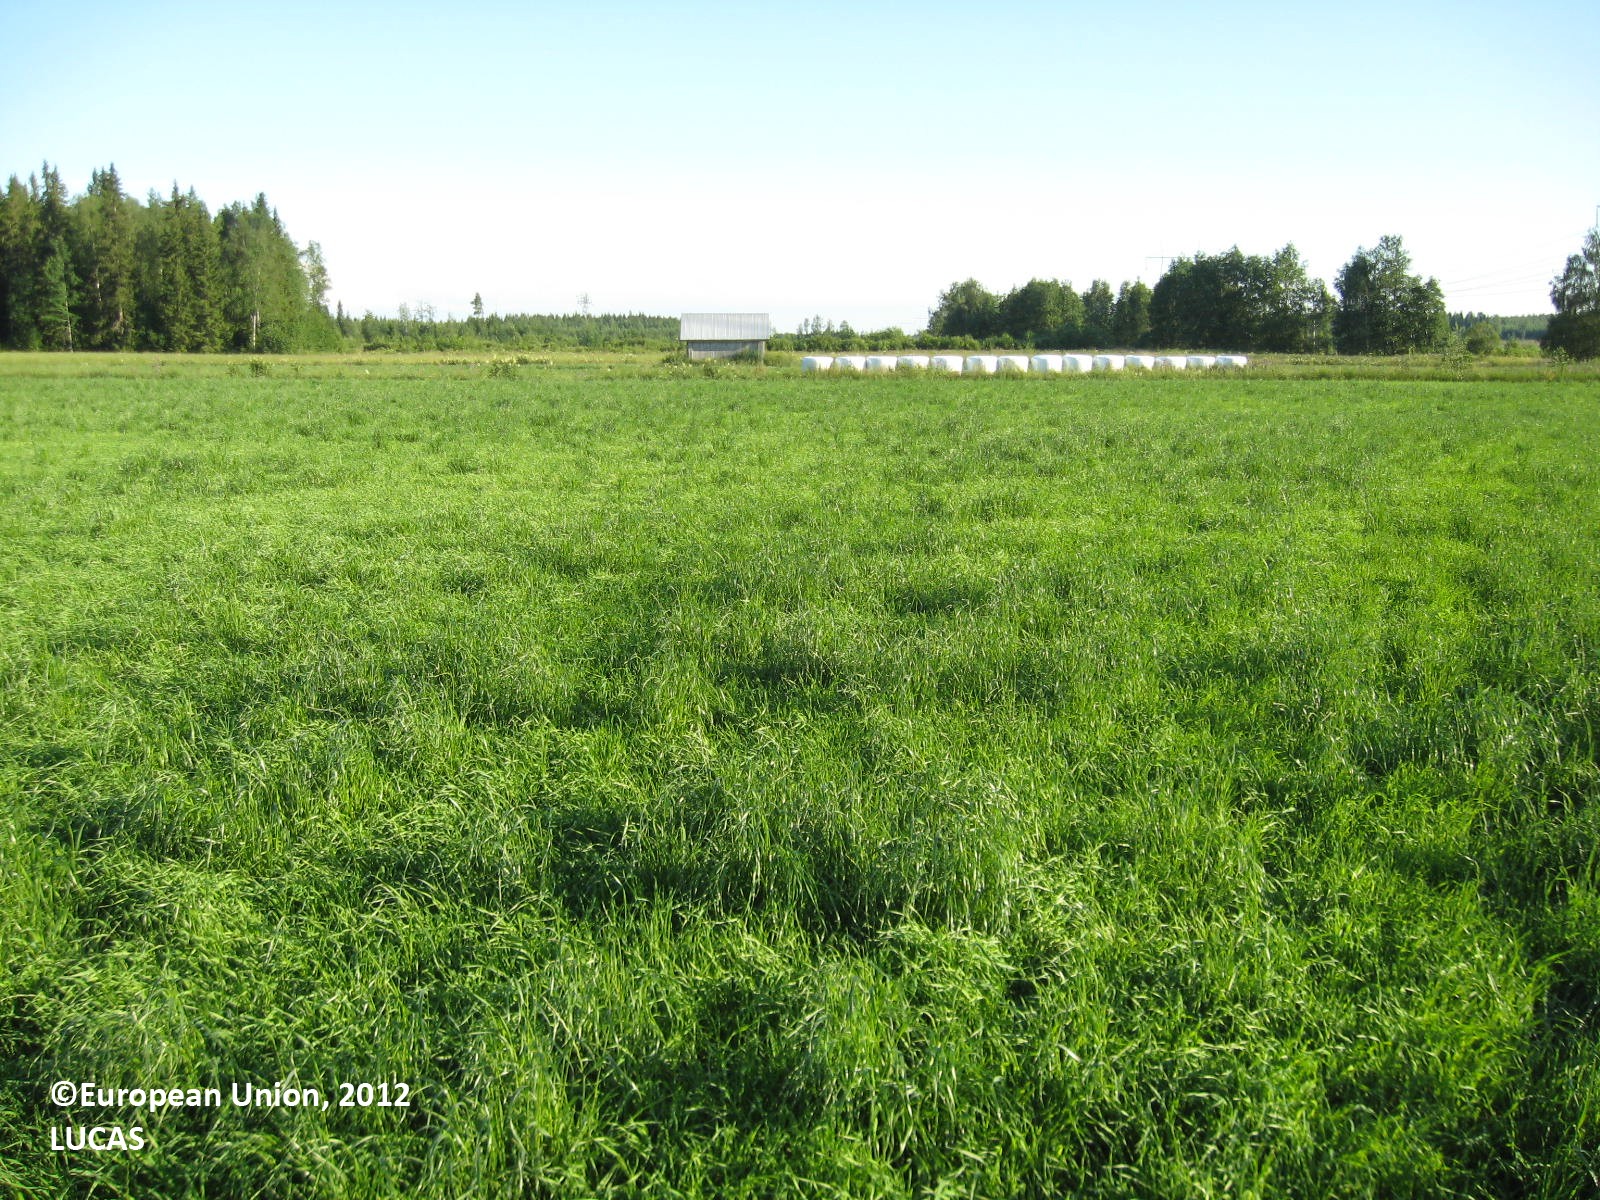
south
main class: Cropland
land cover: Temporary grasslands
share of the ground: > 75 %
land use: Agriculture (excluding fallow land and kitchen gardens)
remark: Harvested field
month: July
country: FI
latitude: 62.3795
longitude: 21.6271
